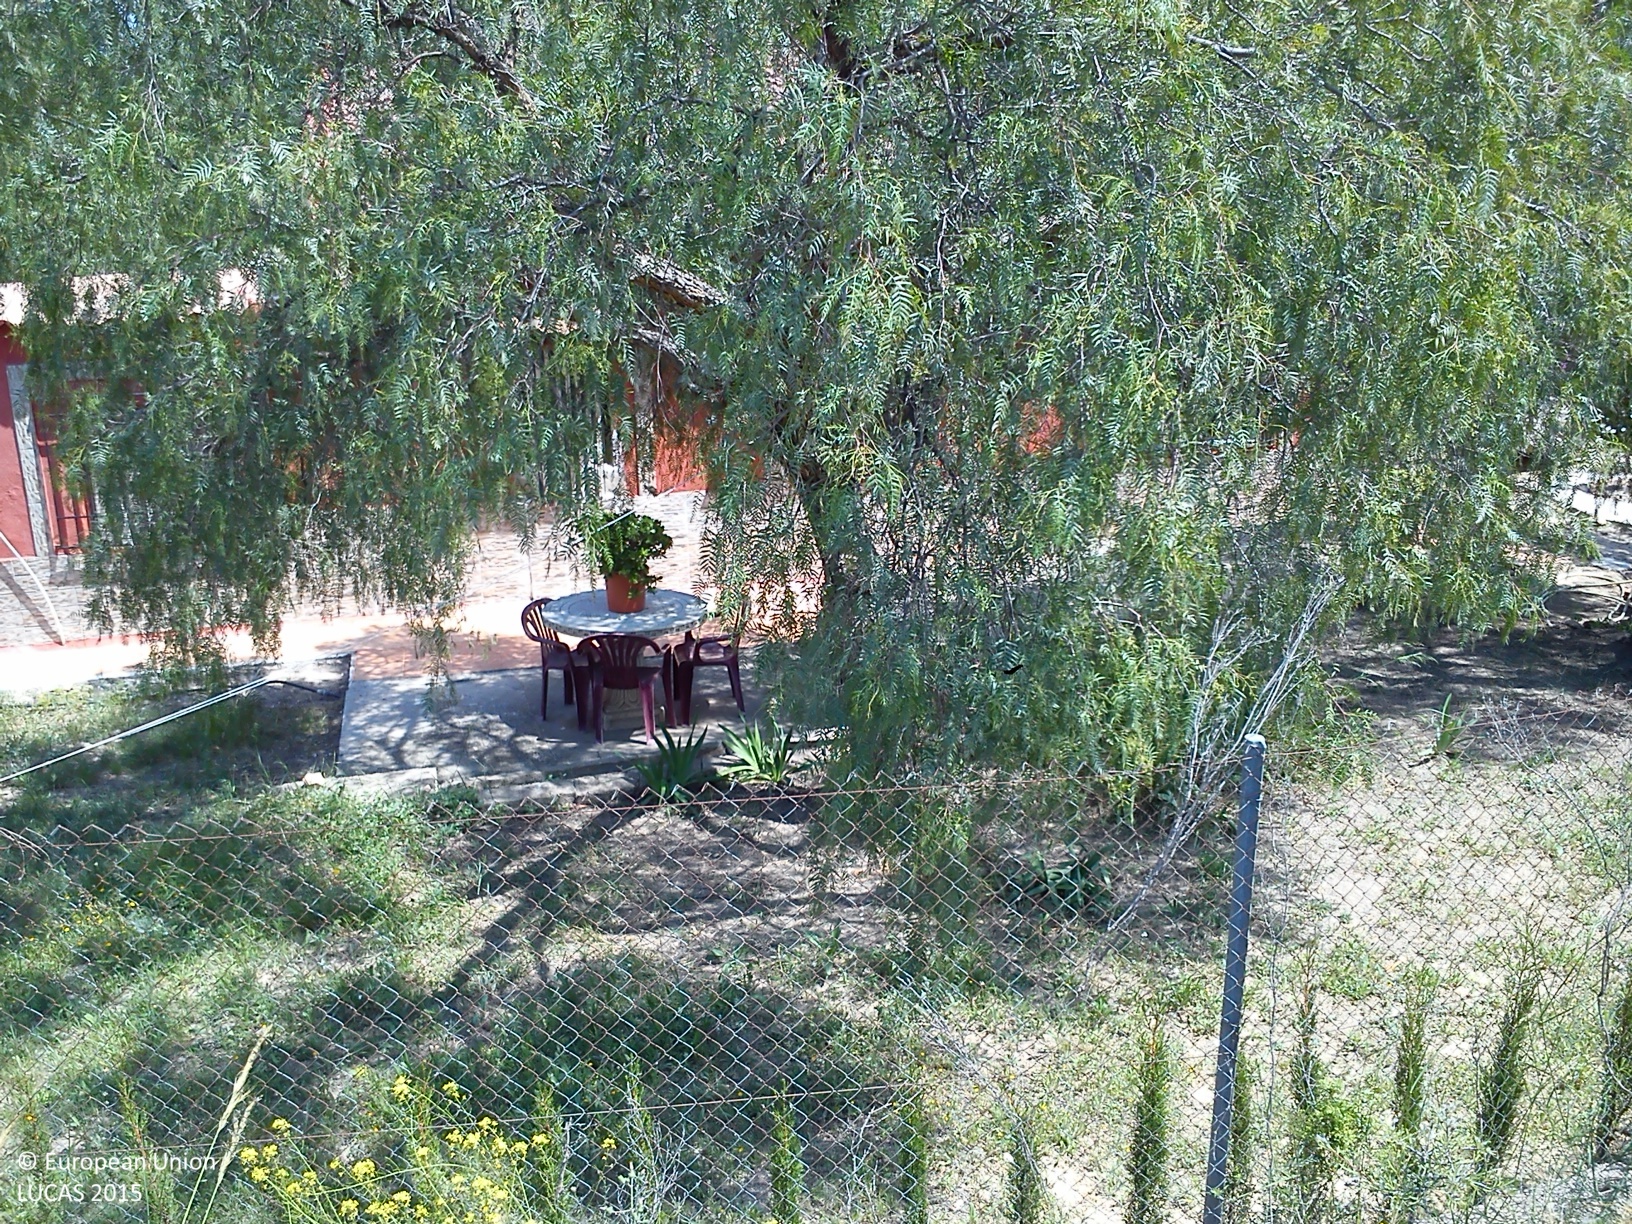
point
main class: Woodland
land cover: Broadleaved woodland
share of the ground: 25 - 50 %
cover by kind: herbaceous plants 50 %, broadleaved forest trees 30 %, consolidated bare surface 20 %
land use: Residential
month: April
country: ES
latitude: 39.6454
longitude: -0.6867
